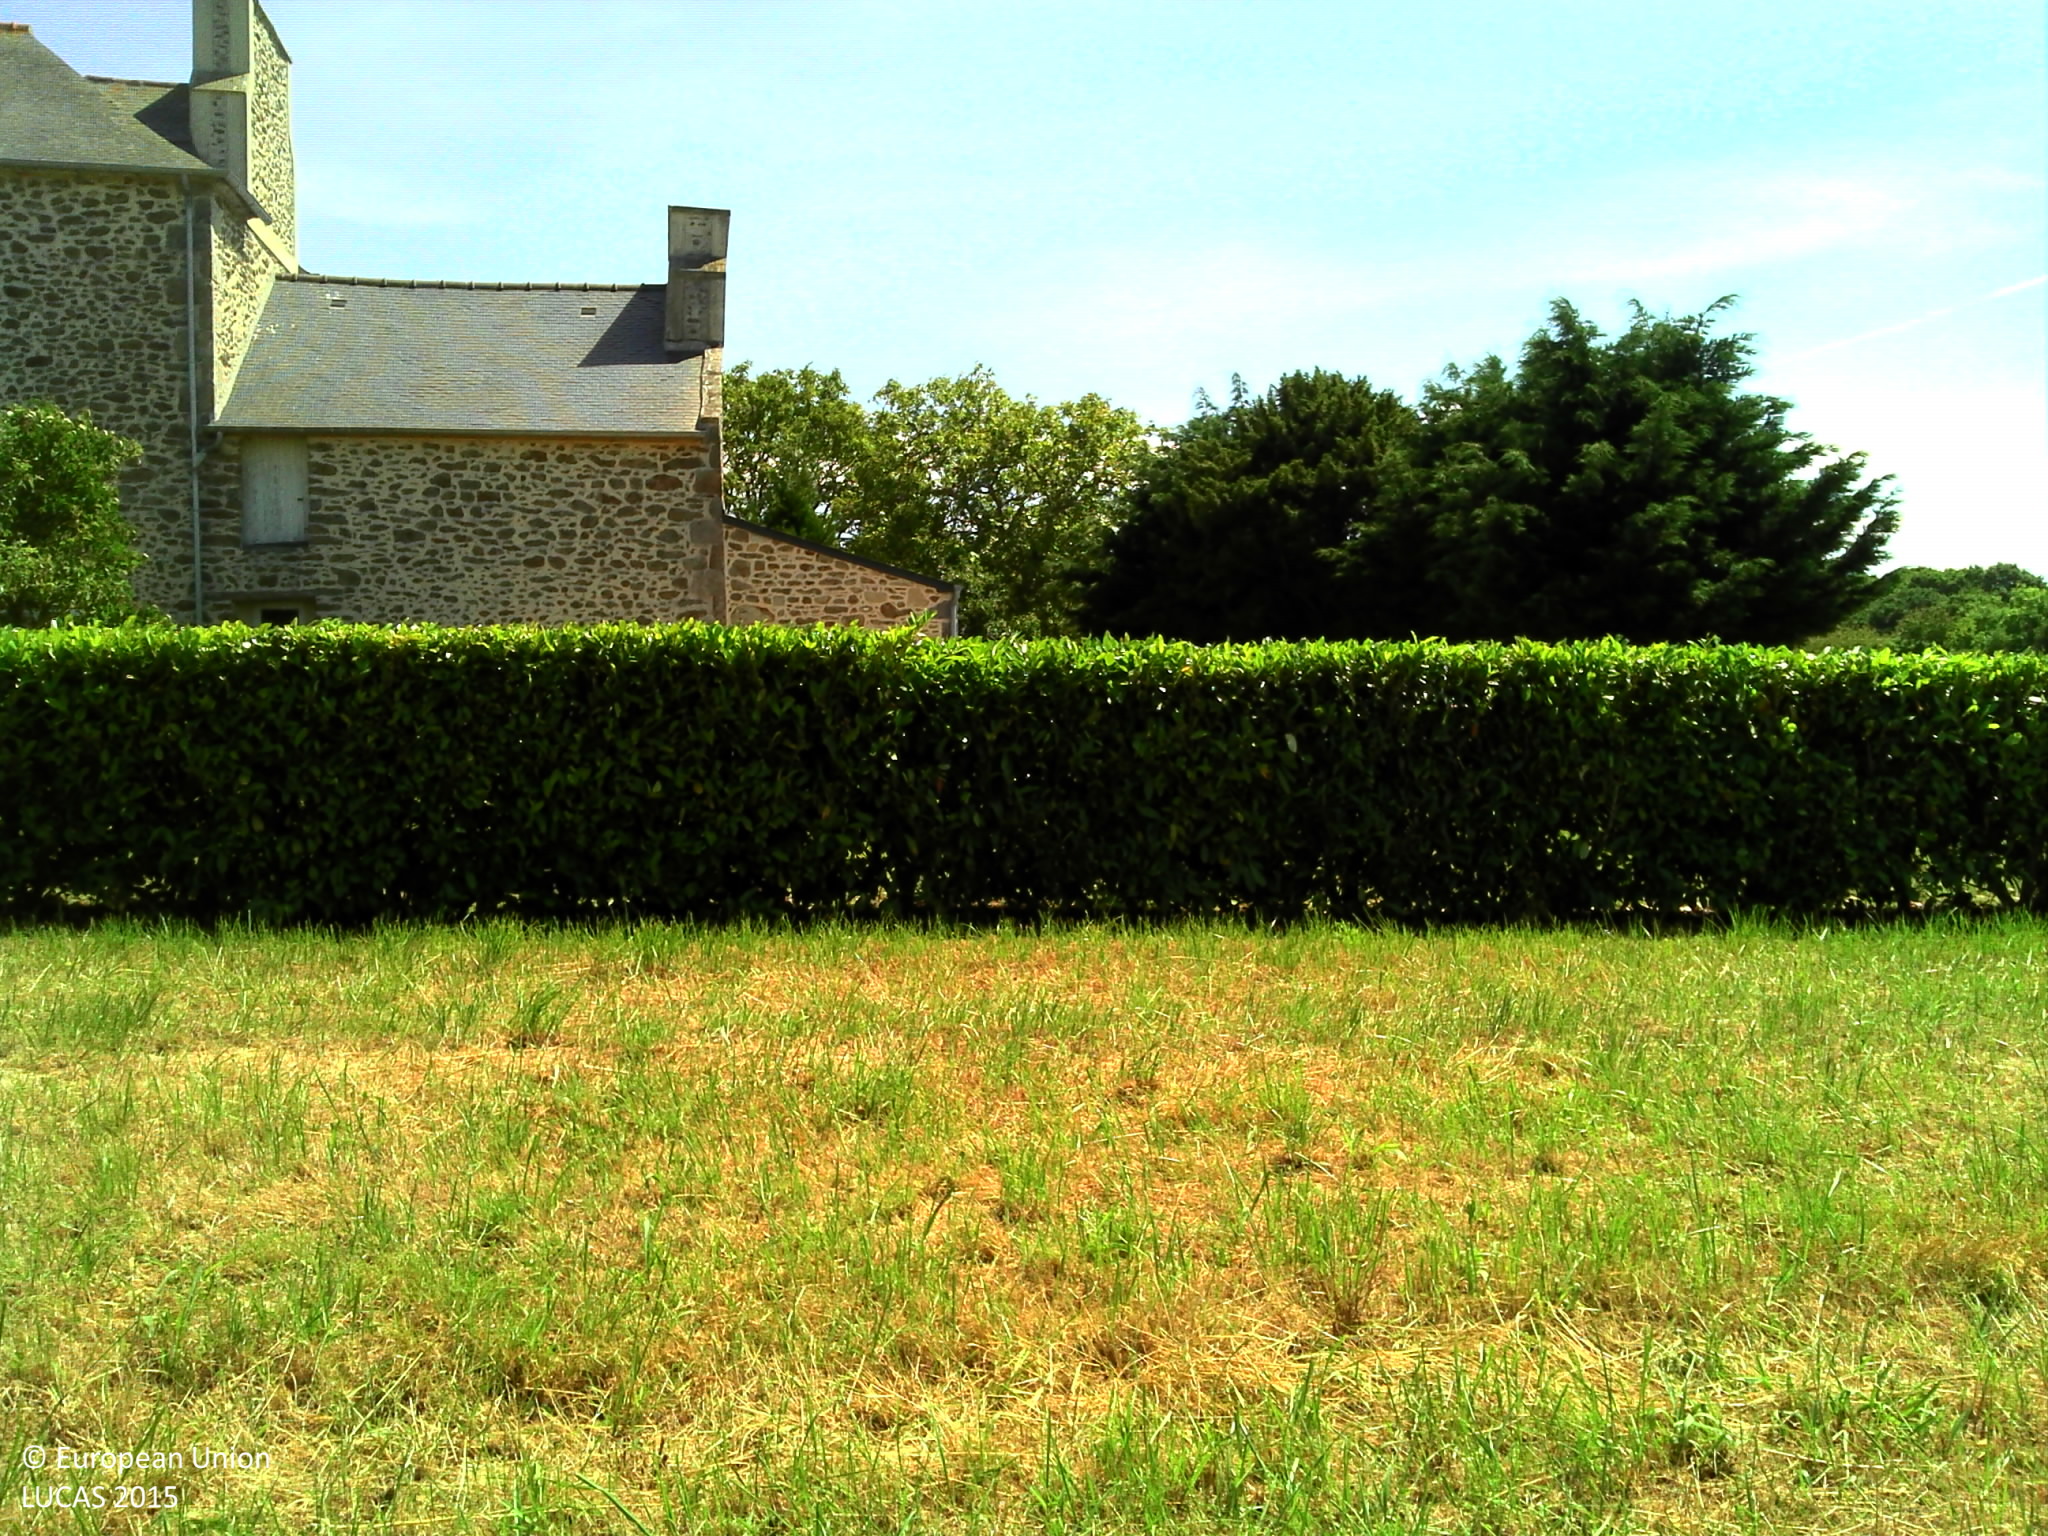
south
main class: Cropland
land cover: Temporary grasslands
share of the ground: > 75 %
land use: Agriculture (excluding fallow land and kitchen gardens)
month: June
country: FR
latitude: 48.6256
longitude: -2.1175
